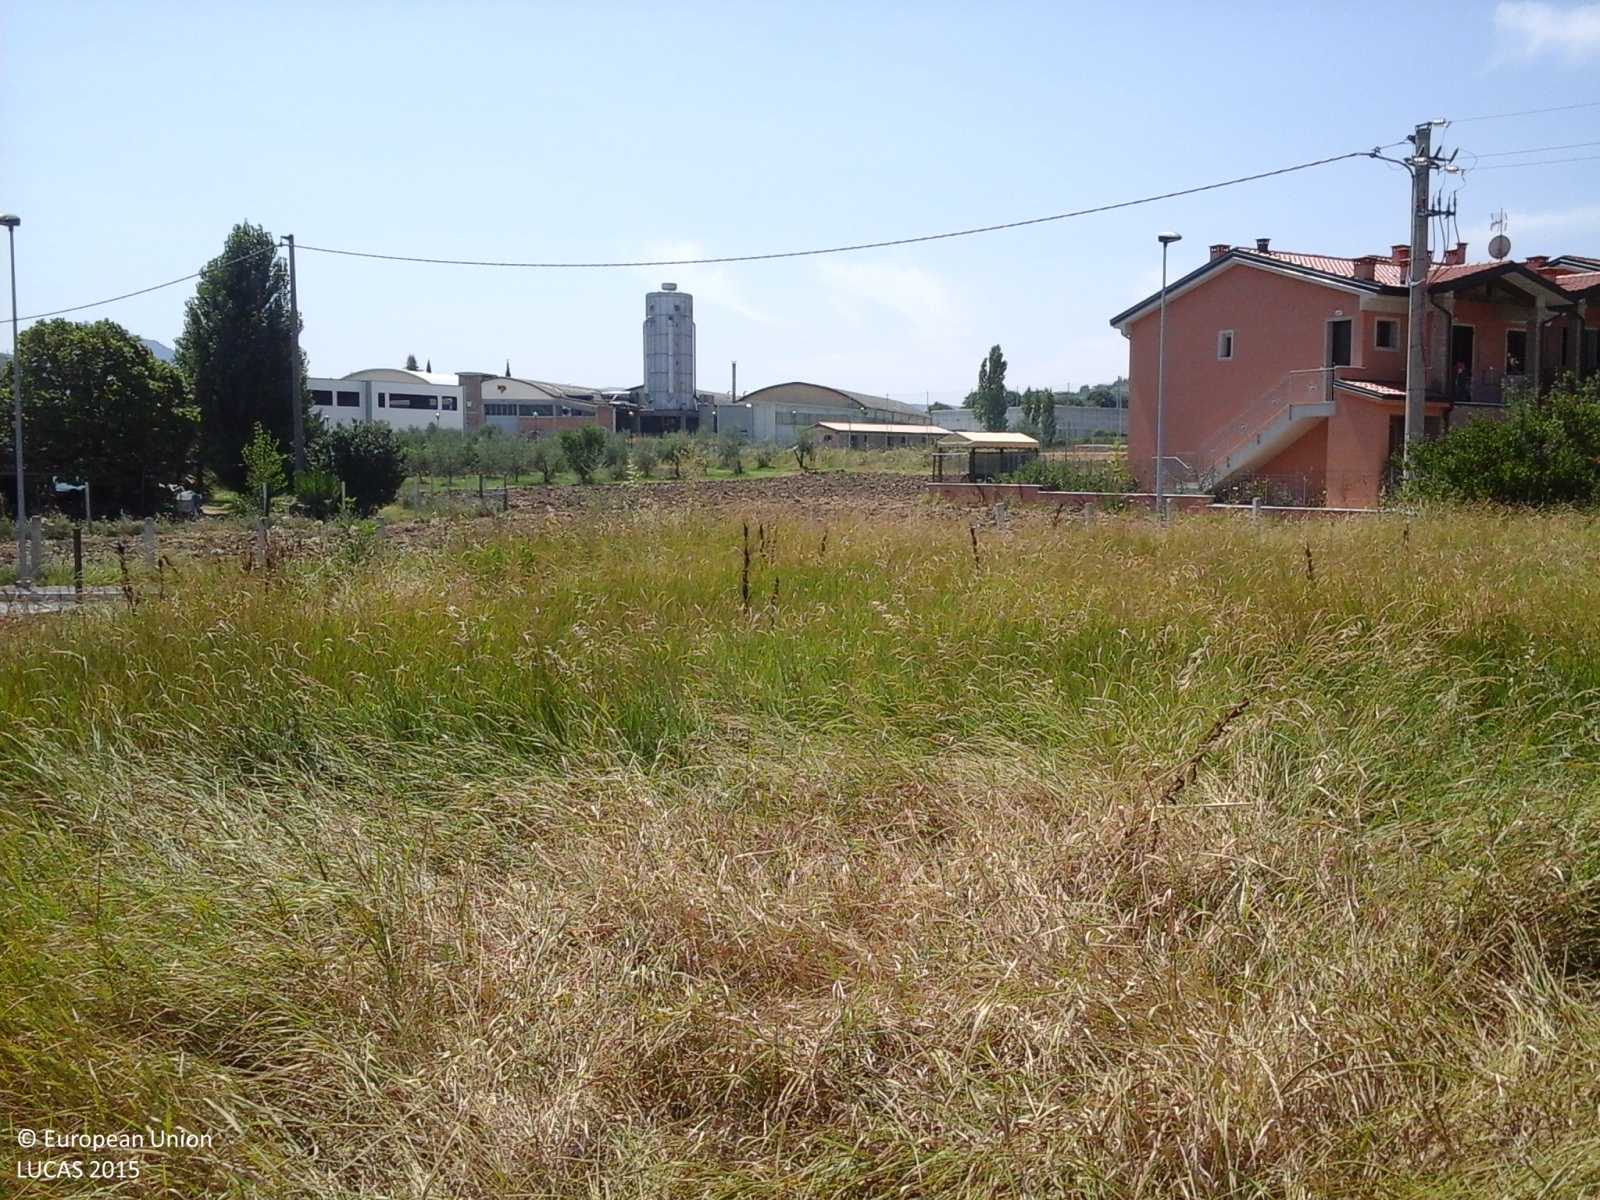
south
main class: Grassland
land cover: Spontaneously vegetated surfaces
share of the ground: > 75 %
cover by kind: herbaceous plants 100 %
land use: Fallow land
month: July
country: IT
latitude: 43.9980
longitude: 12.4012
